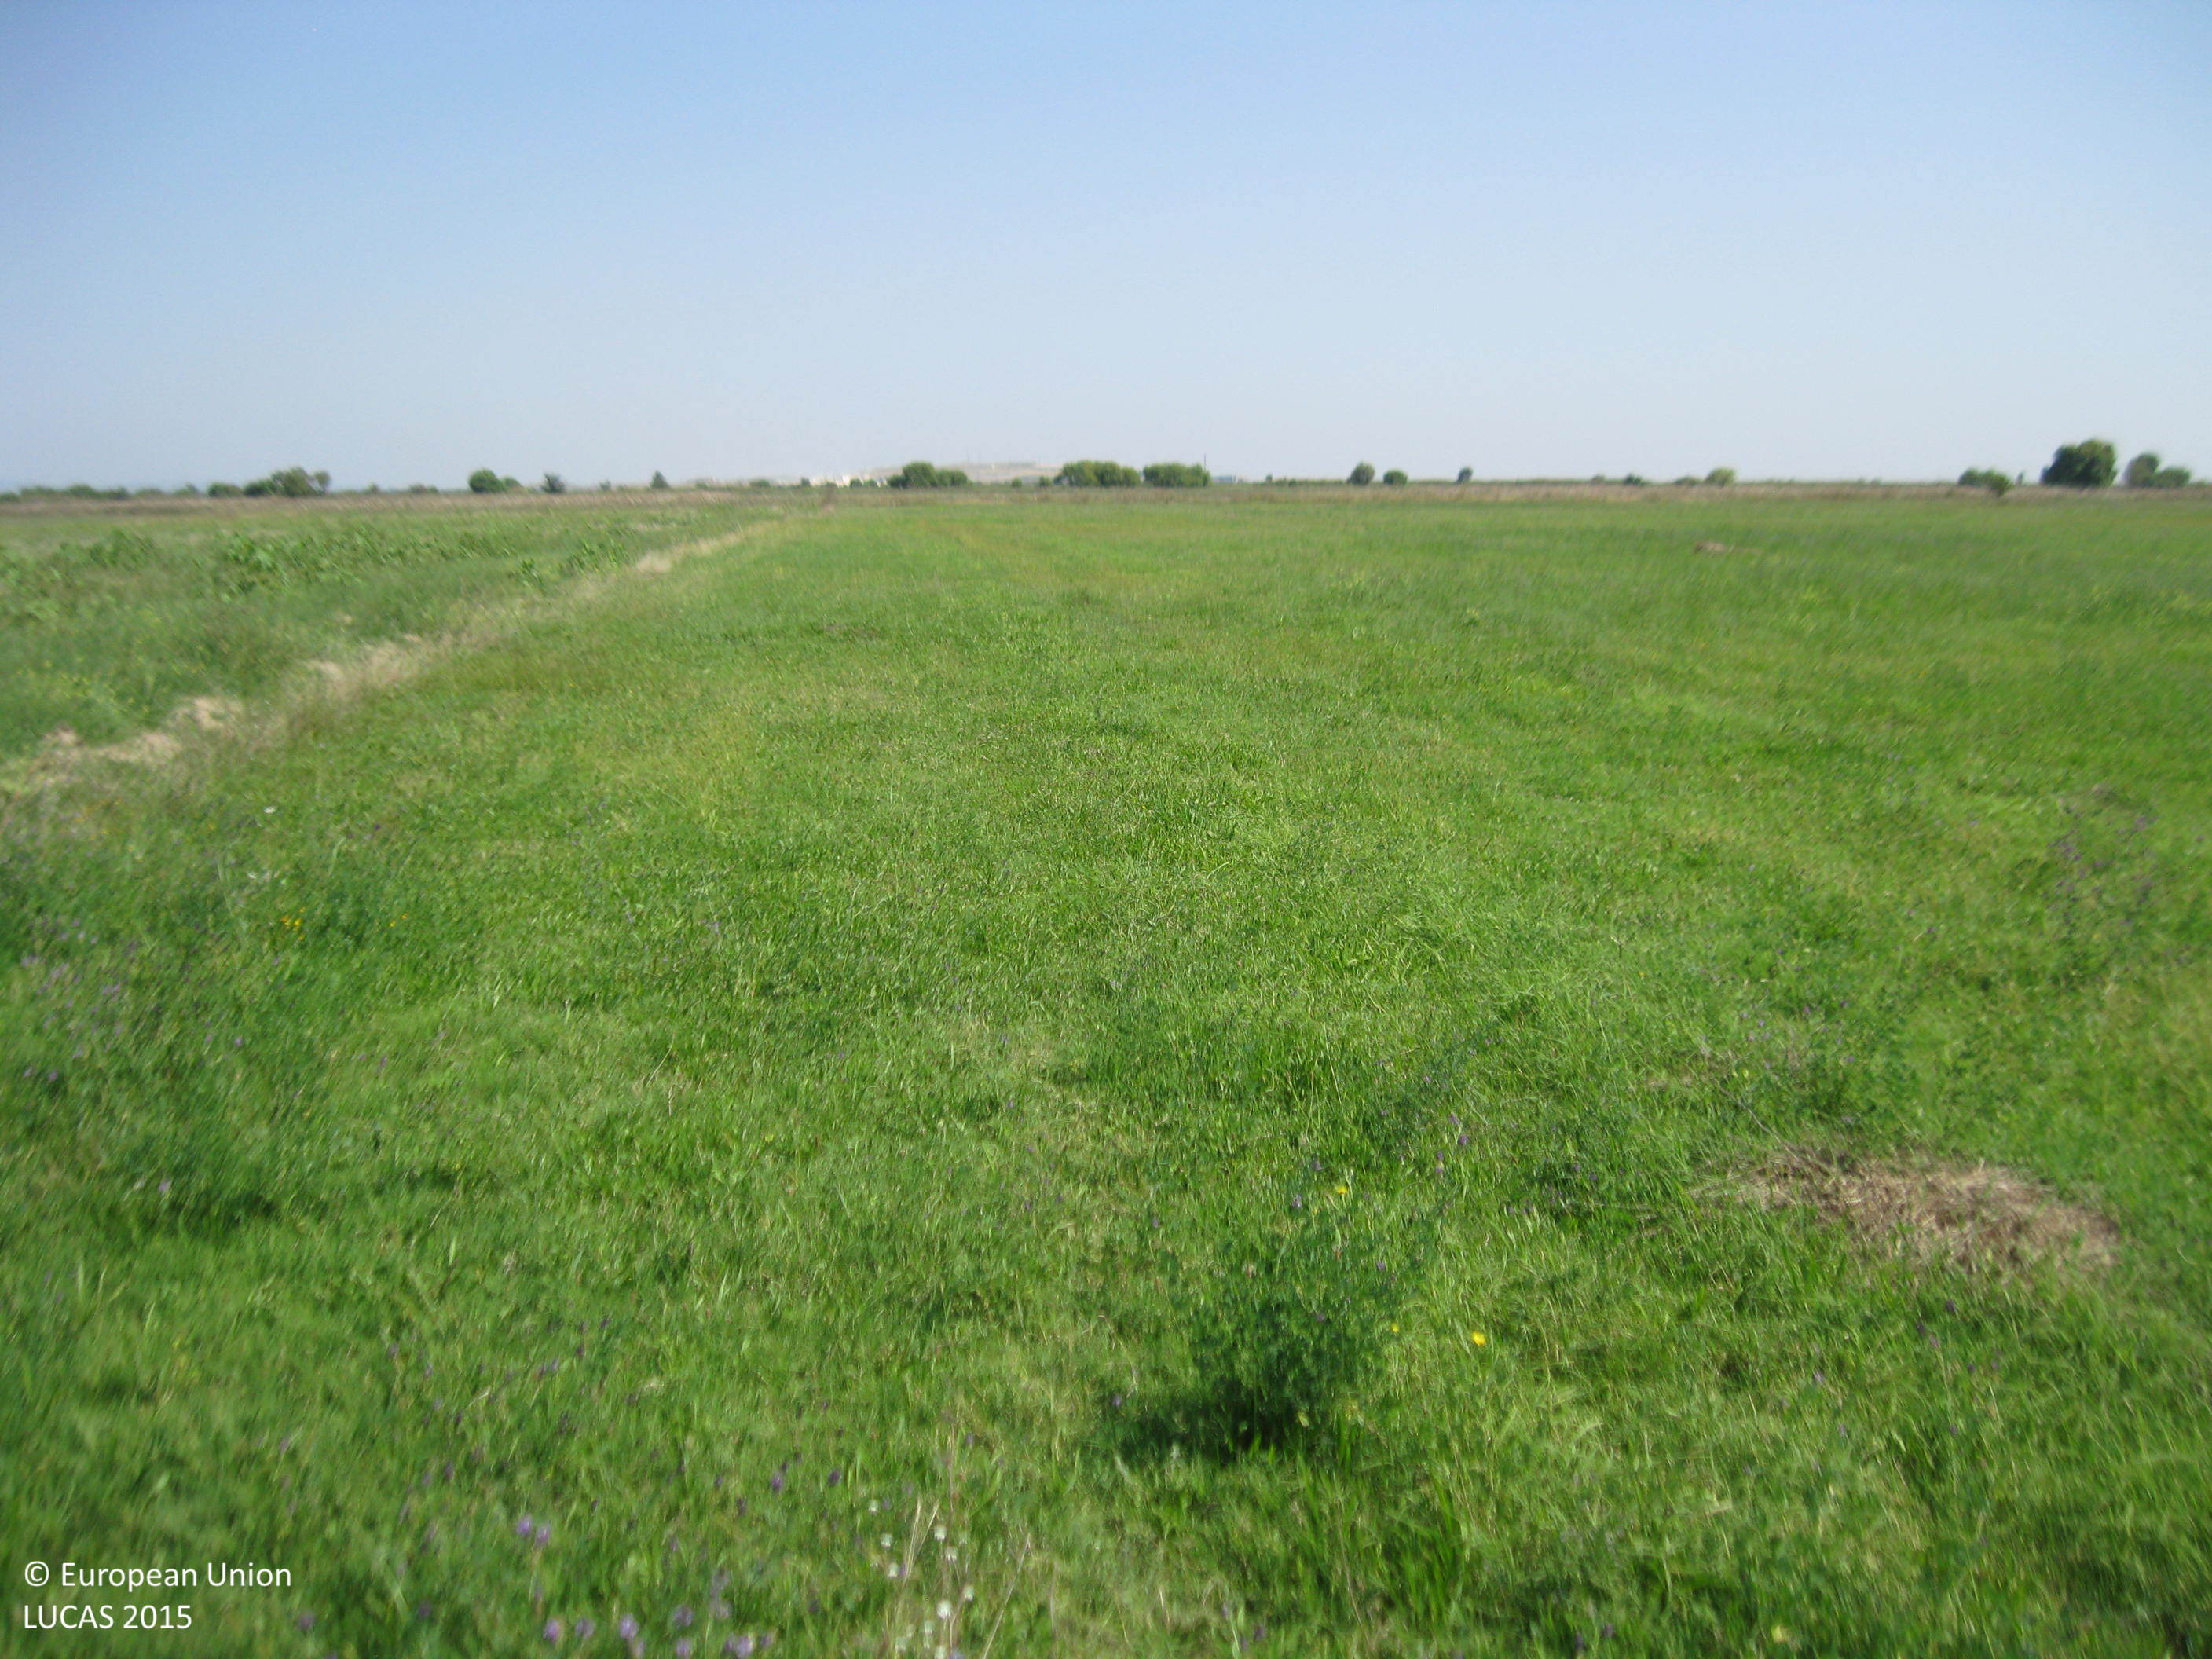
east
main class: Cropland
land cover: Lucerne
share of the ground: > 75 %
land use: Agriculture (excluding fallow land and kitchen gardens)
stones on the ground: < 10 %
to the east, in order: Lucerne; Common wheat; Grass margins; Tracks; Grassland without tree/shrub cover
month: September
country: BG
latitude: 42.2343
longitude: 24.9484
